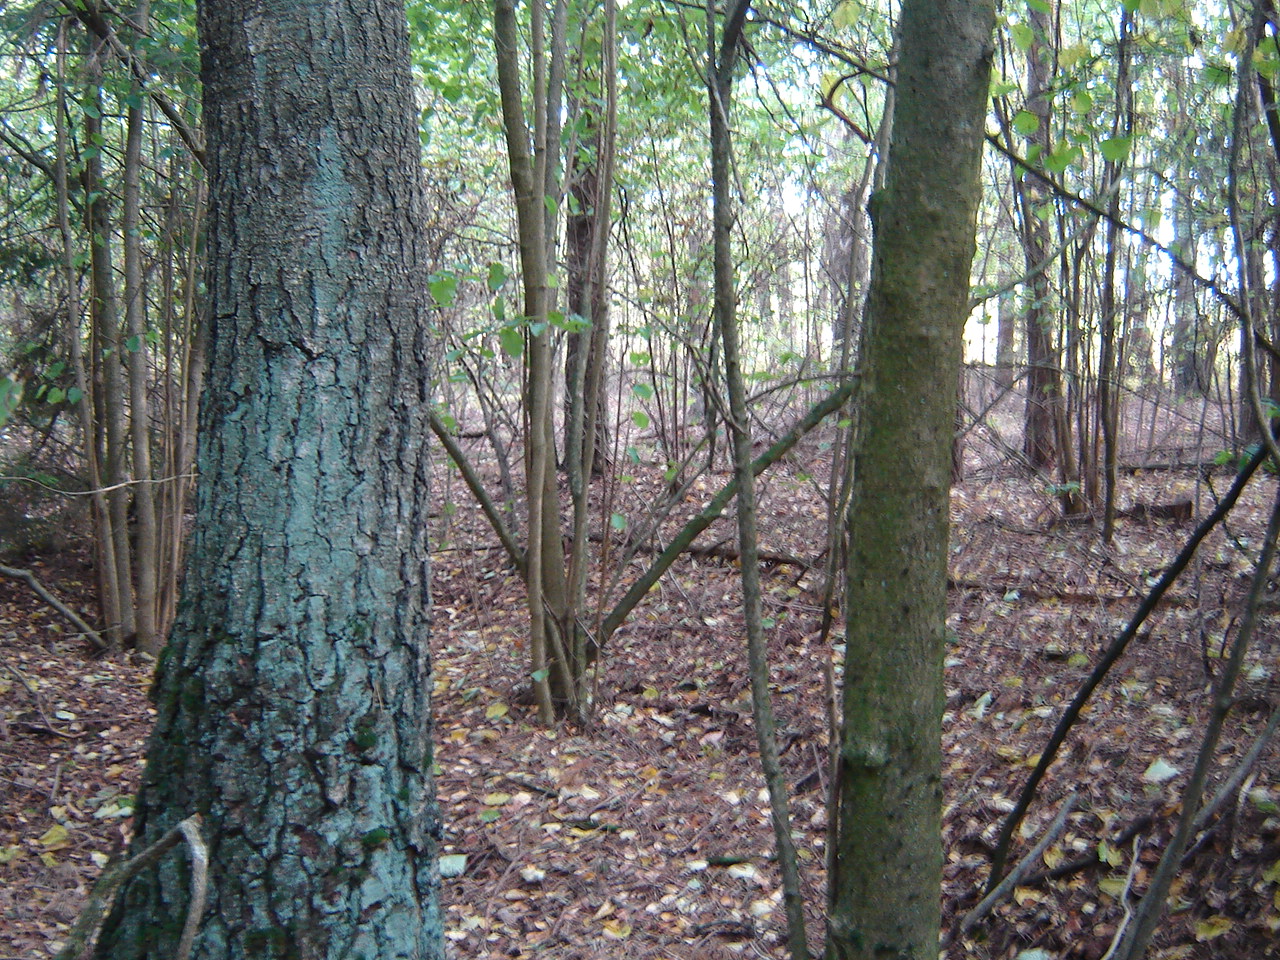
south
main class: Woodland
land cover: Pine dominated mixed woodland
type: hemiboreal forest and nemoral coniferous forest and mixed broadleaved-coniferous forest
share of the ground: > 75 %
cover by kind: broadleaved forest trees 50 %, coniferous forest trees 40 %, herbaceous plants 5 %, unconsolidated bare surface 5 %
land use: Forestry
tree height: > 5 m
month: September
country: LT
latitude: 54.1958
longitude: 25.0300
